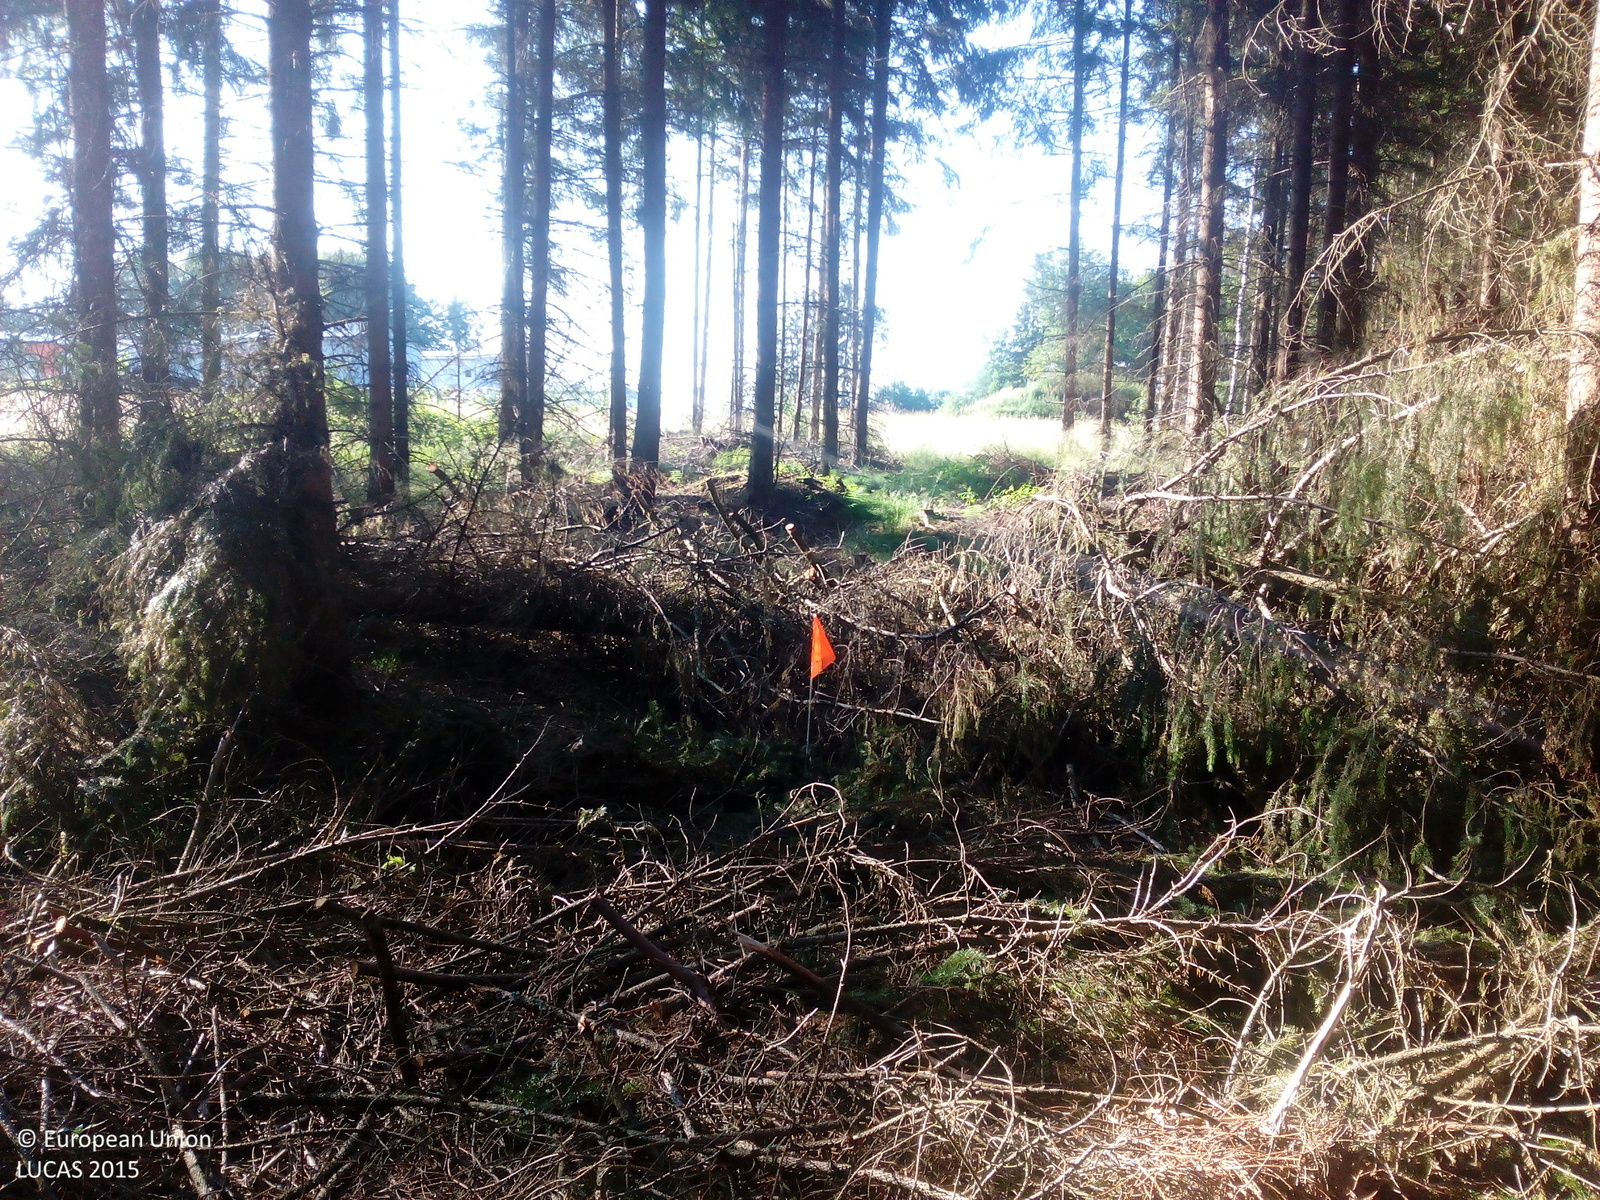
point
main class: Woodland
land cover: Spruce dominated coniferous woodland
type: hemiboreal forest and nemoral coniferous forest and mixed broadleaved-coniferous forest
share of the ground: > 75 %
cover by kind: coniferous forest trees 80 %, lichens and mosses 10 %, unconsolidated bare surface 10 %
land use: Forestry
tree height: > 5 m
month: July
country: DE
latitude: 49.6200
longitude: 12.3665
